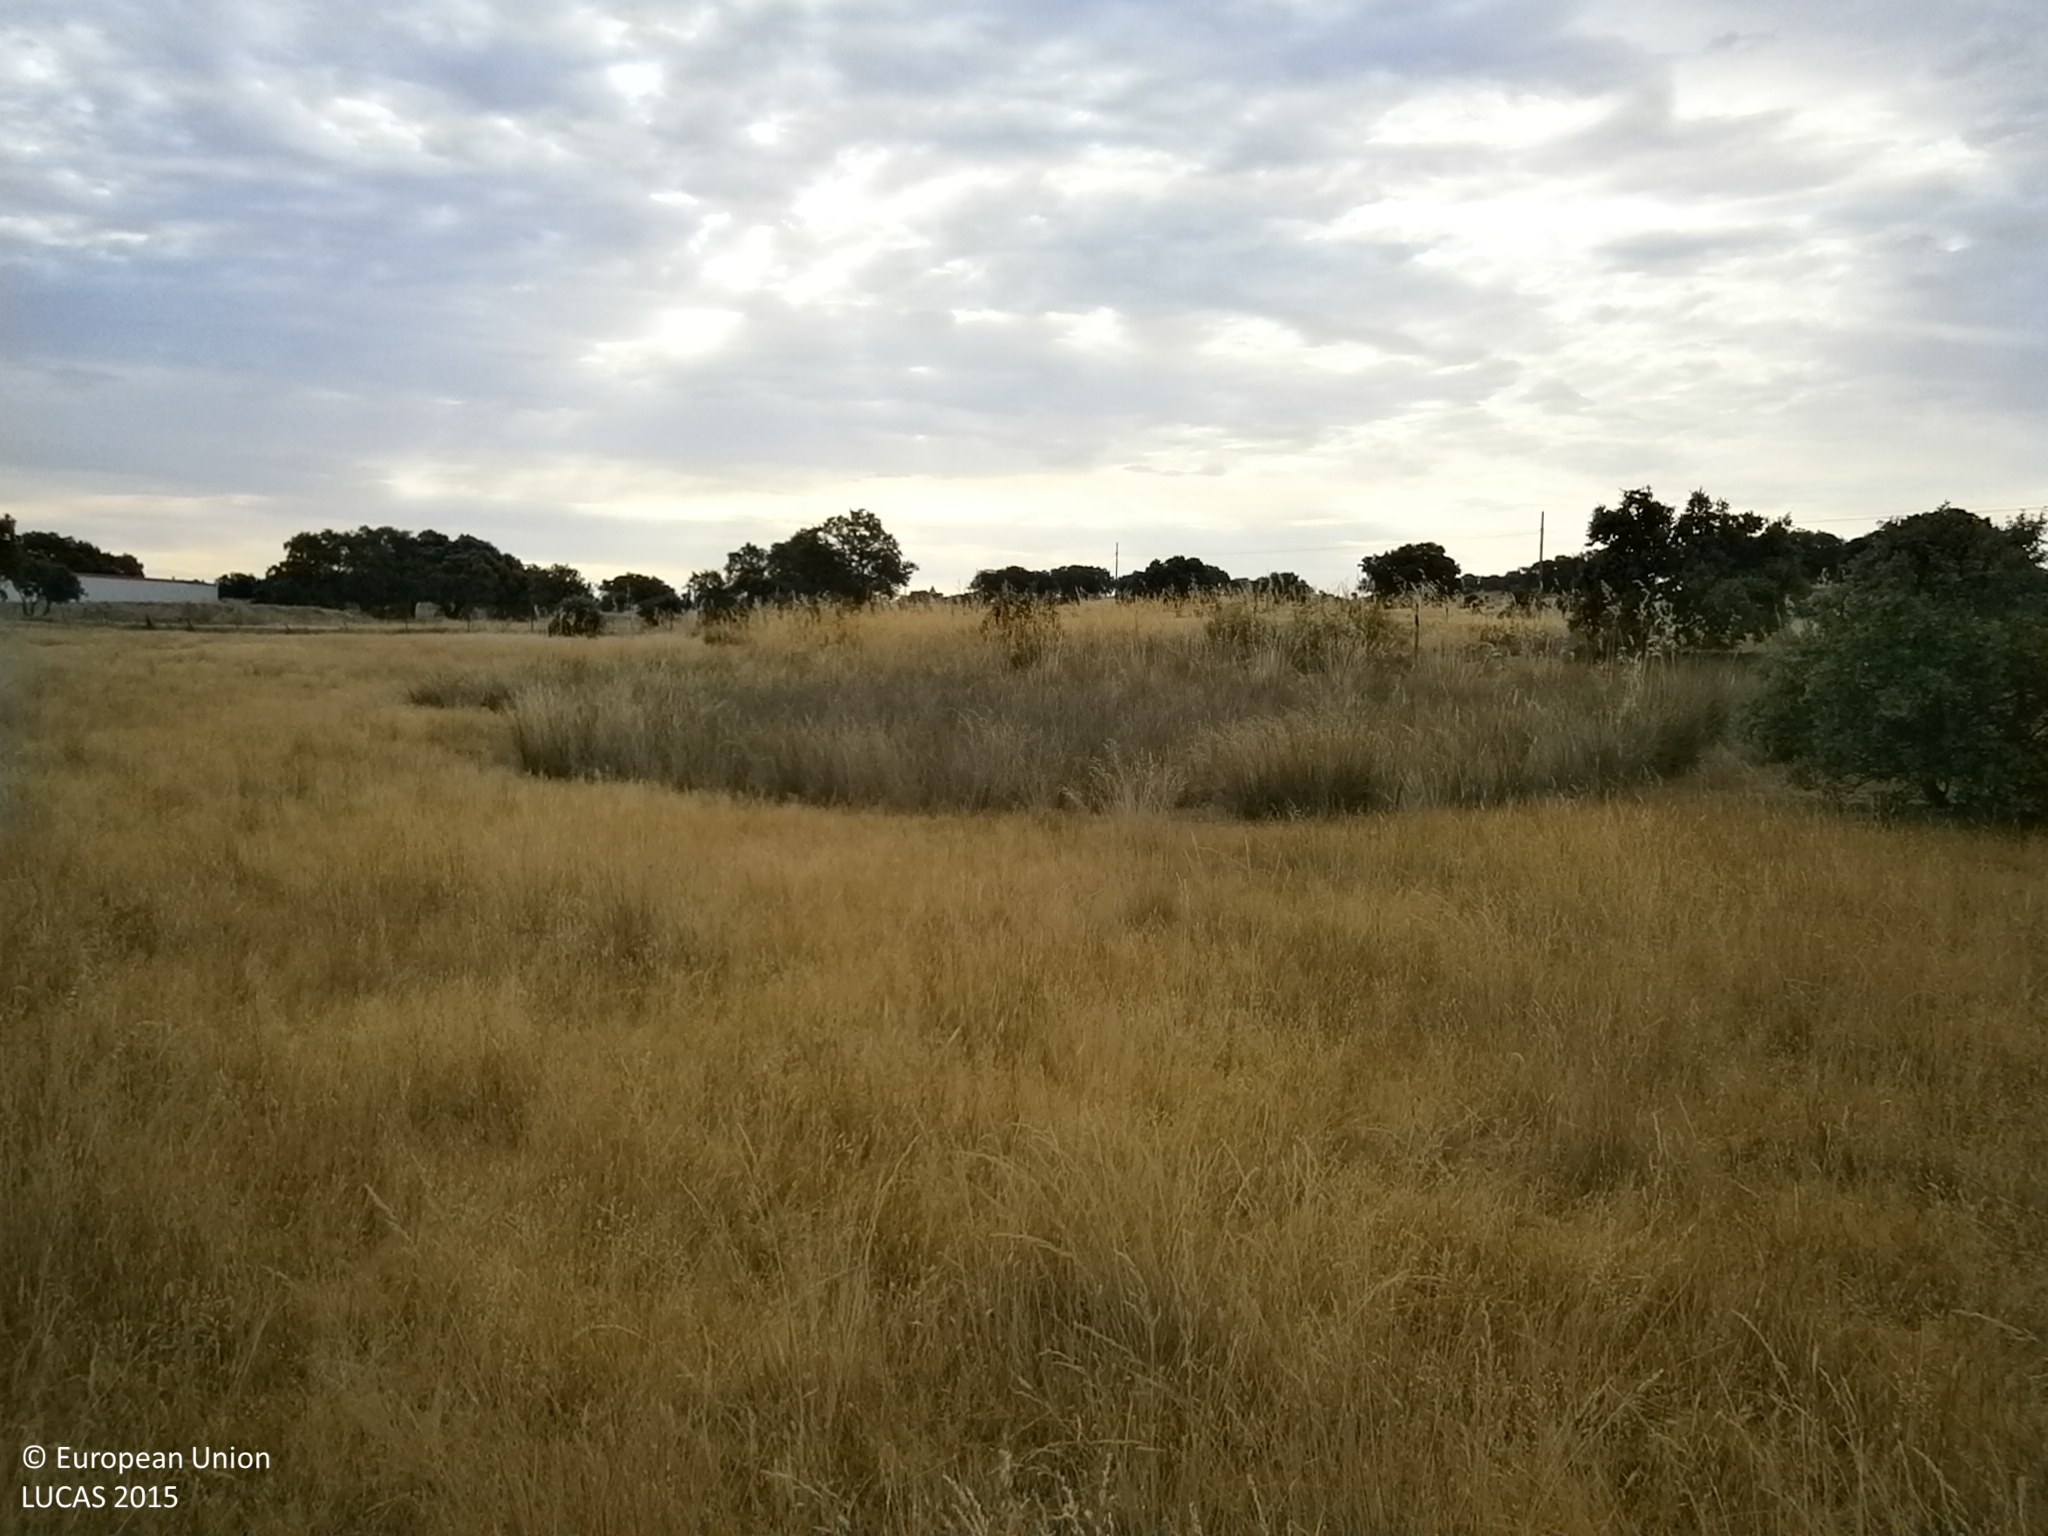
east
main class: Grassland
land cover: Grassland with sparse tree/shrub cover
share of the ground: > 75 %
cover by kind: herbaceous plants 90 %, broadleaved forest trees 5 %, shrubs 5 %
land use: Sport
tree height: > 5 m
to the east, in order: Grassland with sparse tree/shrub cover; Fences; Spontaneously vegetated surfaces; Paved roads, cycling and walking lanes; Spontaneously vegetated surfaces; Fences; Grassland with sparse tree/shrub cover
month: June
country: ES
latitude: 38.9819
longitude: -6.3236
